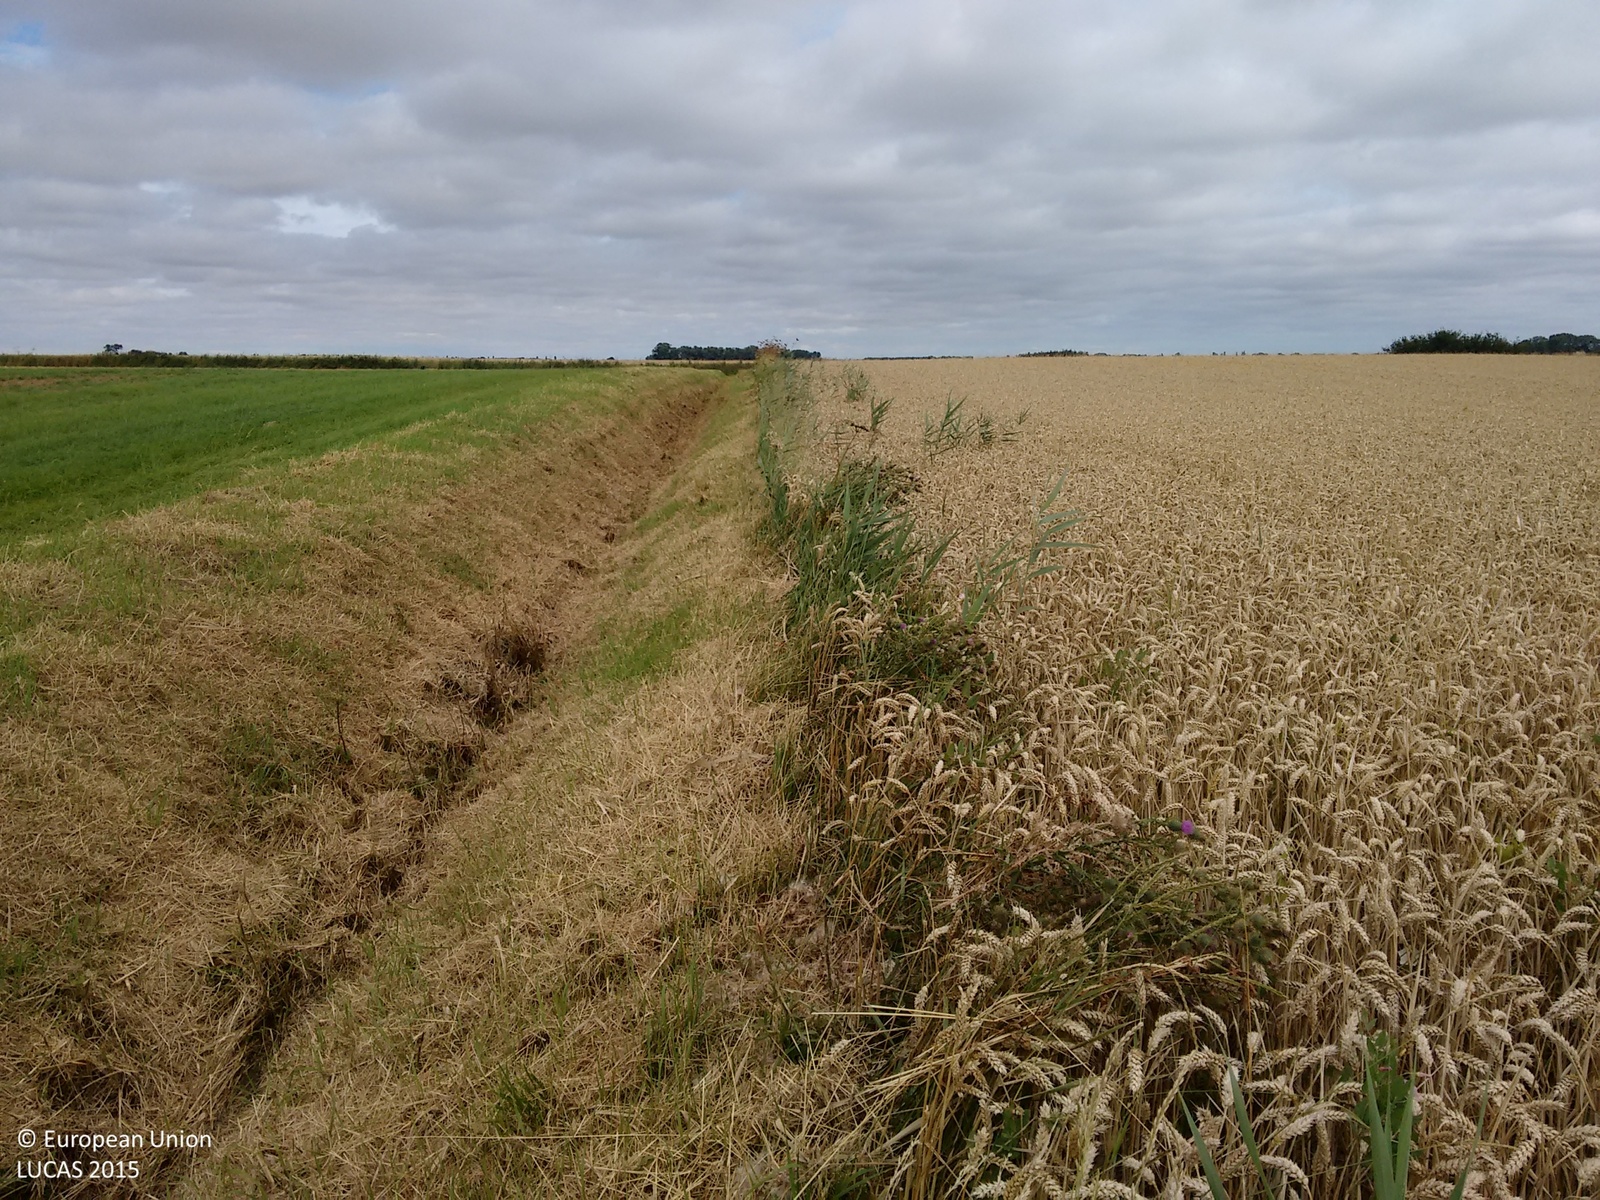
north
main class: Cropland
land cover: Common wheat
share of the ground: > 75 %
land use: Agriculture (excluding fallow land and kitchen gardens)
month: August
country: GB
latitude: 52.6356
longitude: 0.3517
